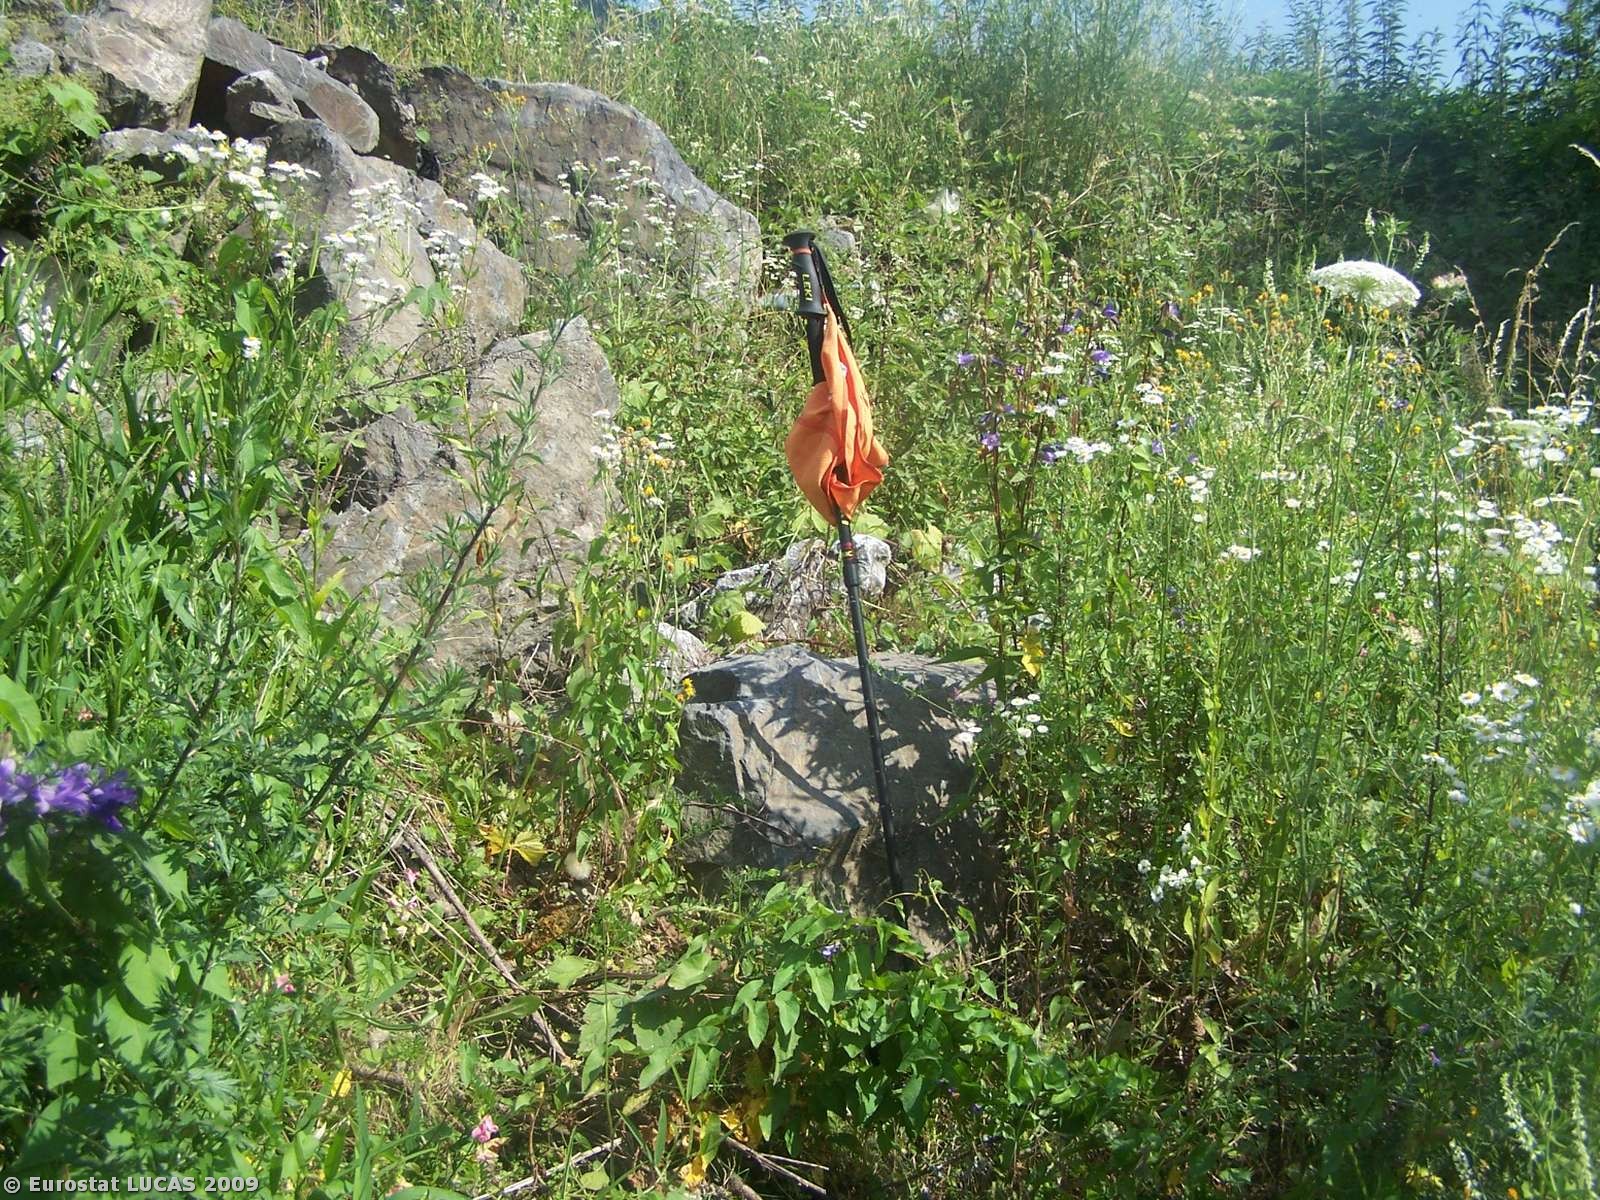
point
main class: Grassland
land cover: Spontaneously vegetated surfaces
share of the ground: 50 - 75 %
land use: Mining and quarrying
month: July
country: IT
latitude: 46.5612
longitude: 13.0105
